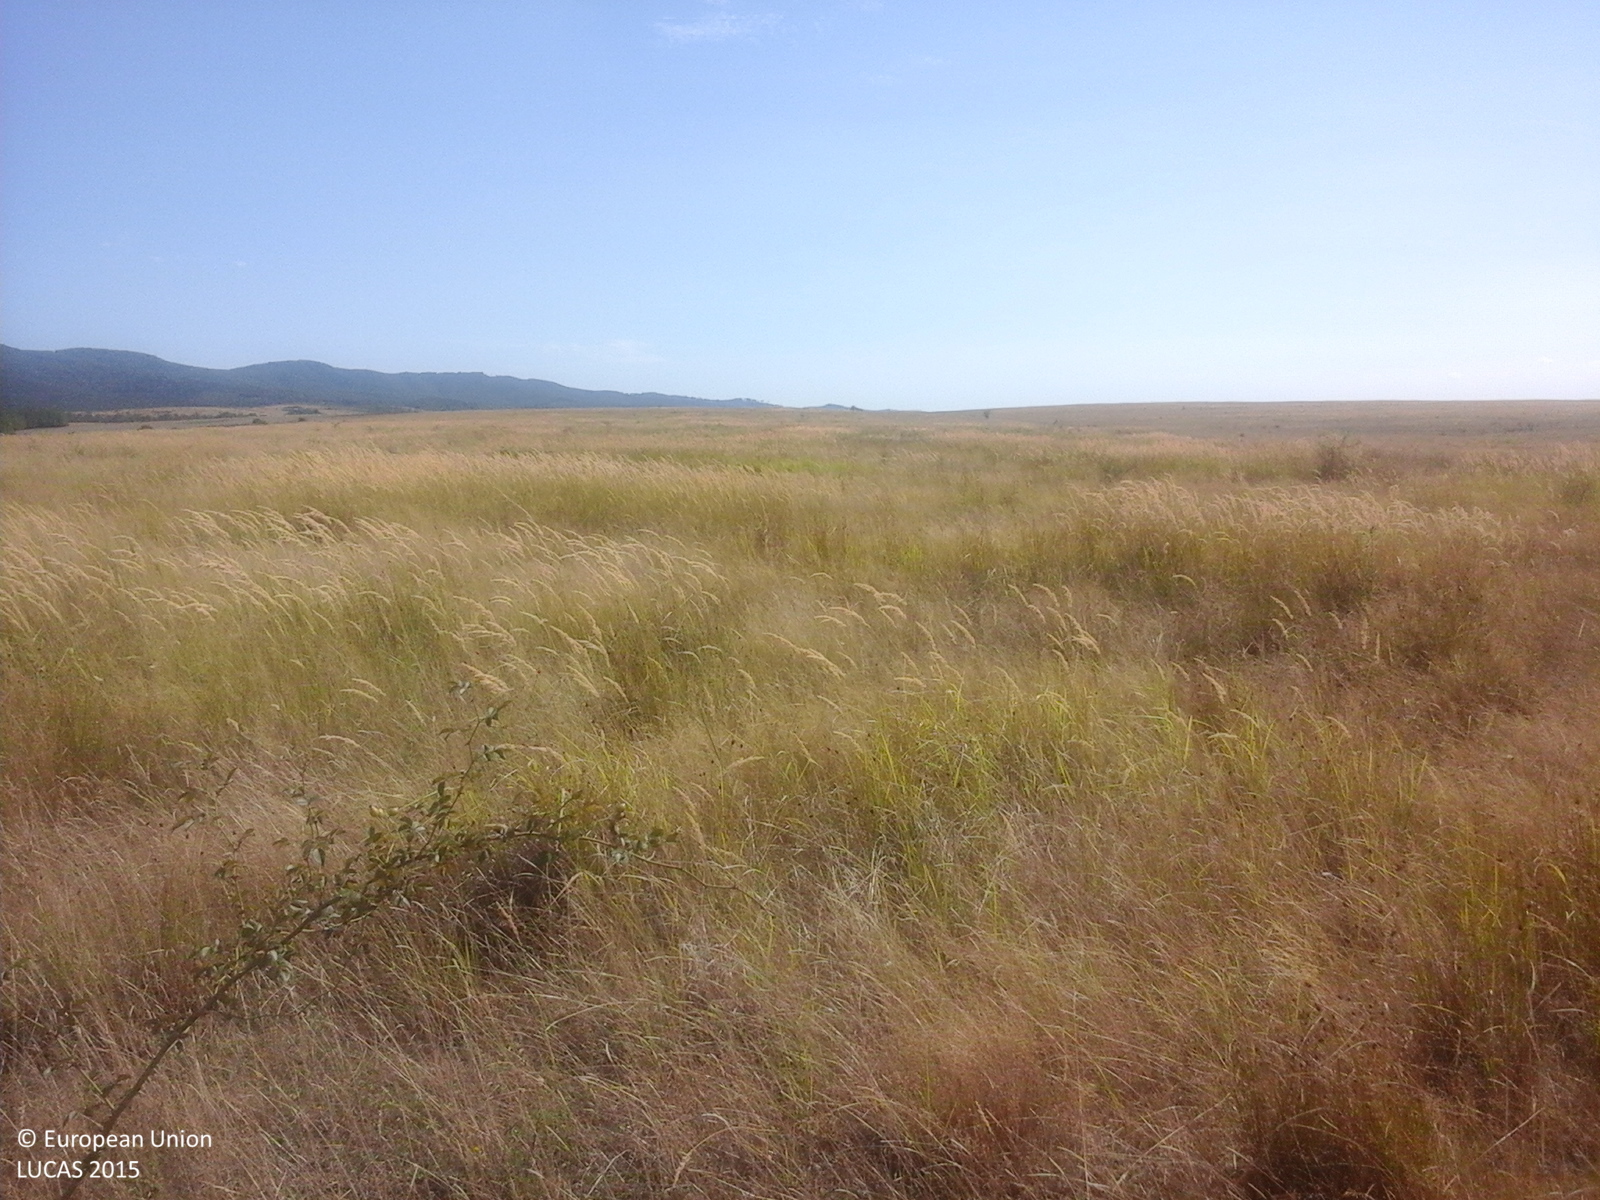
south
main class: Grassland
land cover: Spontaneously vegetated surfaces
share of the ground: > 75 %
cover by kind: herbaceous plants 100 %
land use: Fallow land
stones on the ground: < 10 %
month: August
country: RO
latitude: 45.3621
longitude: 21.6896
